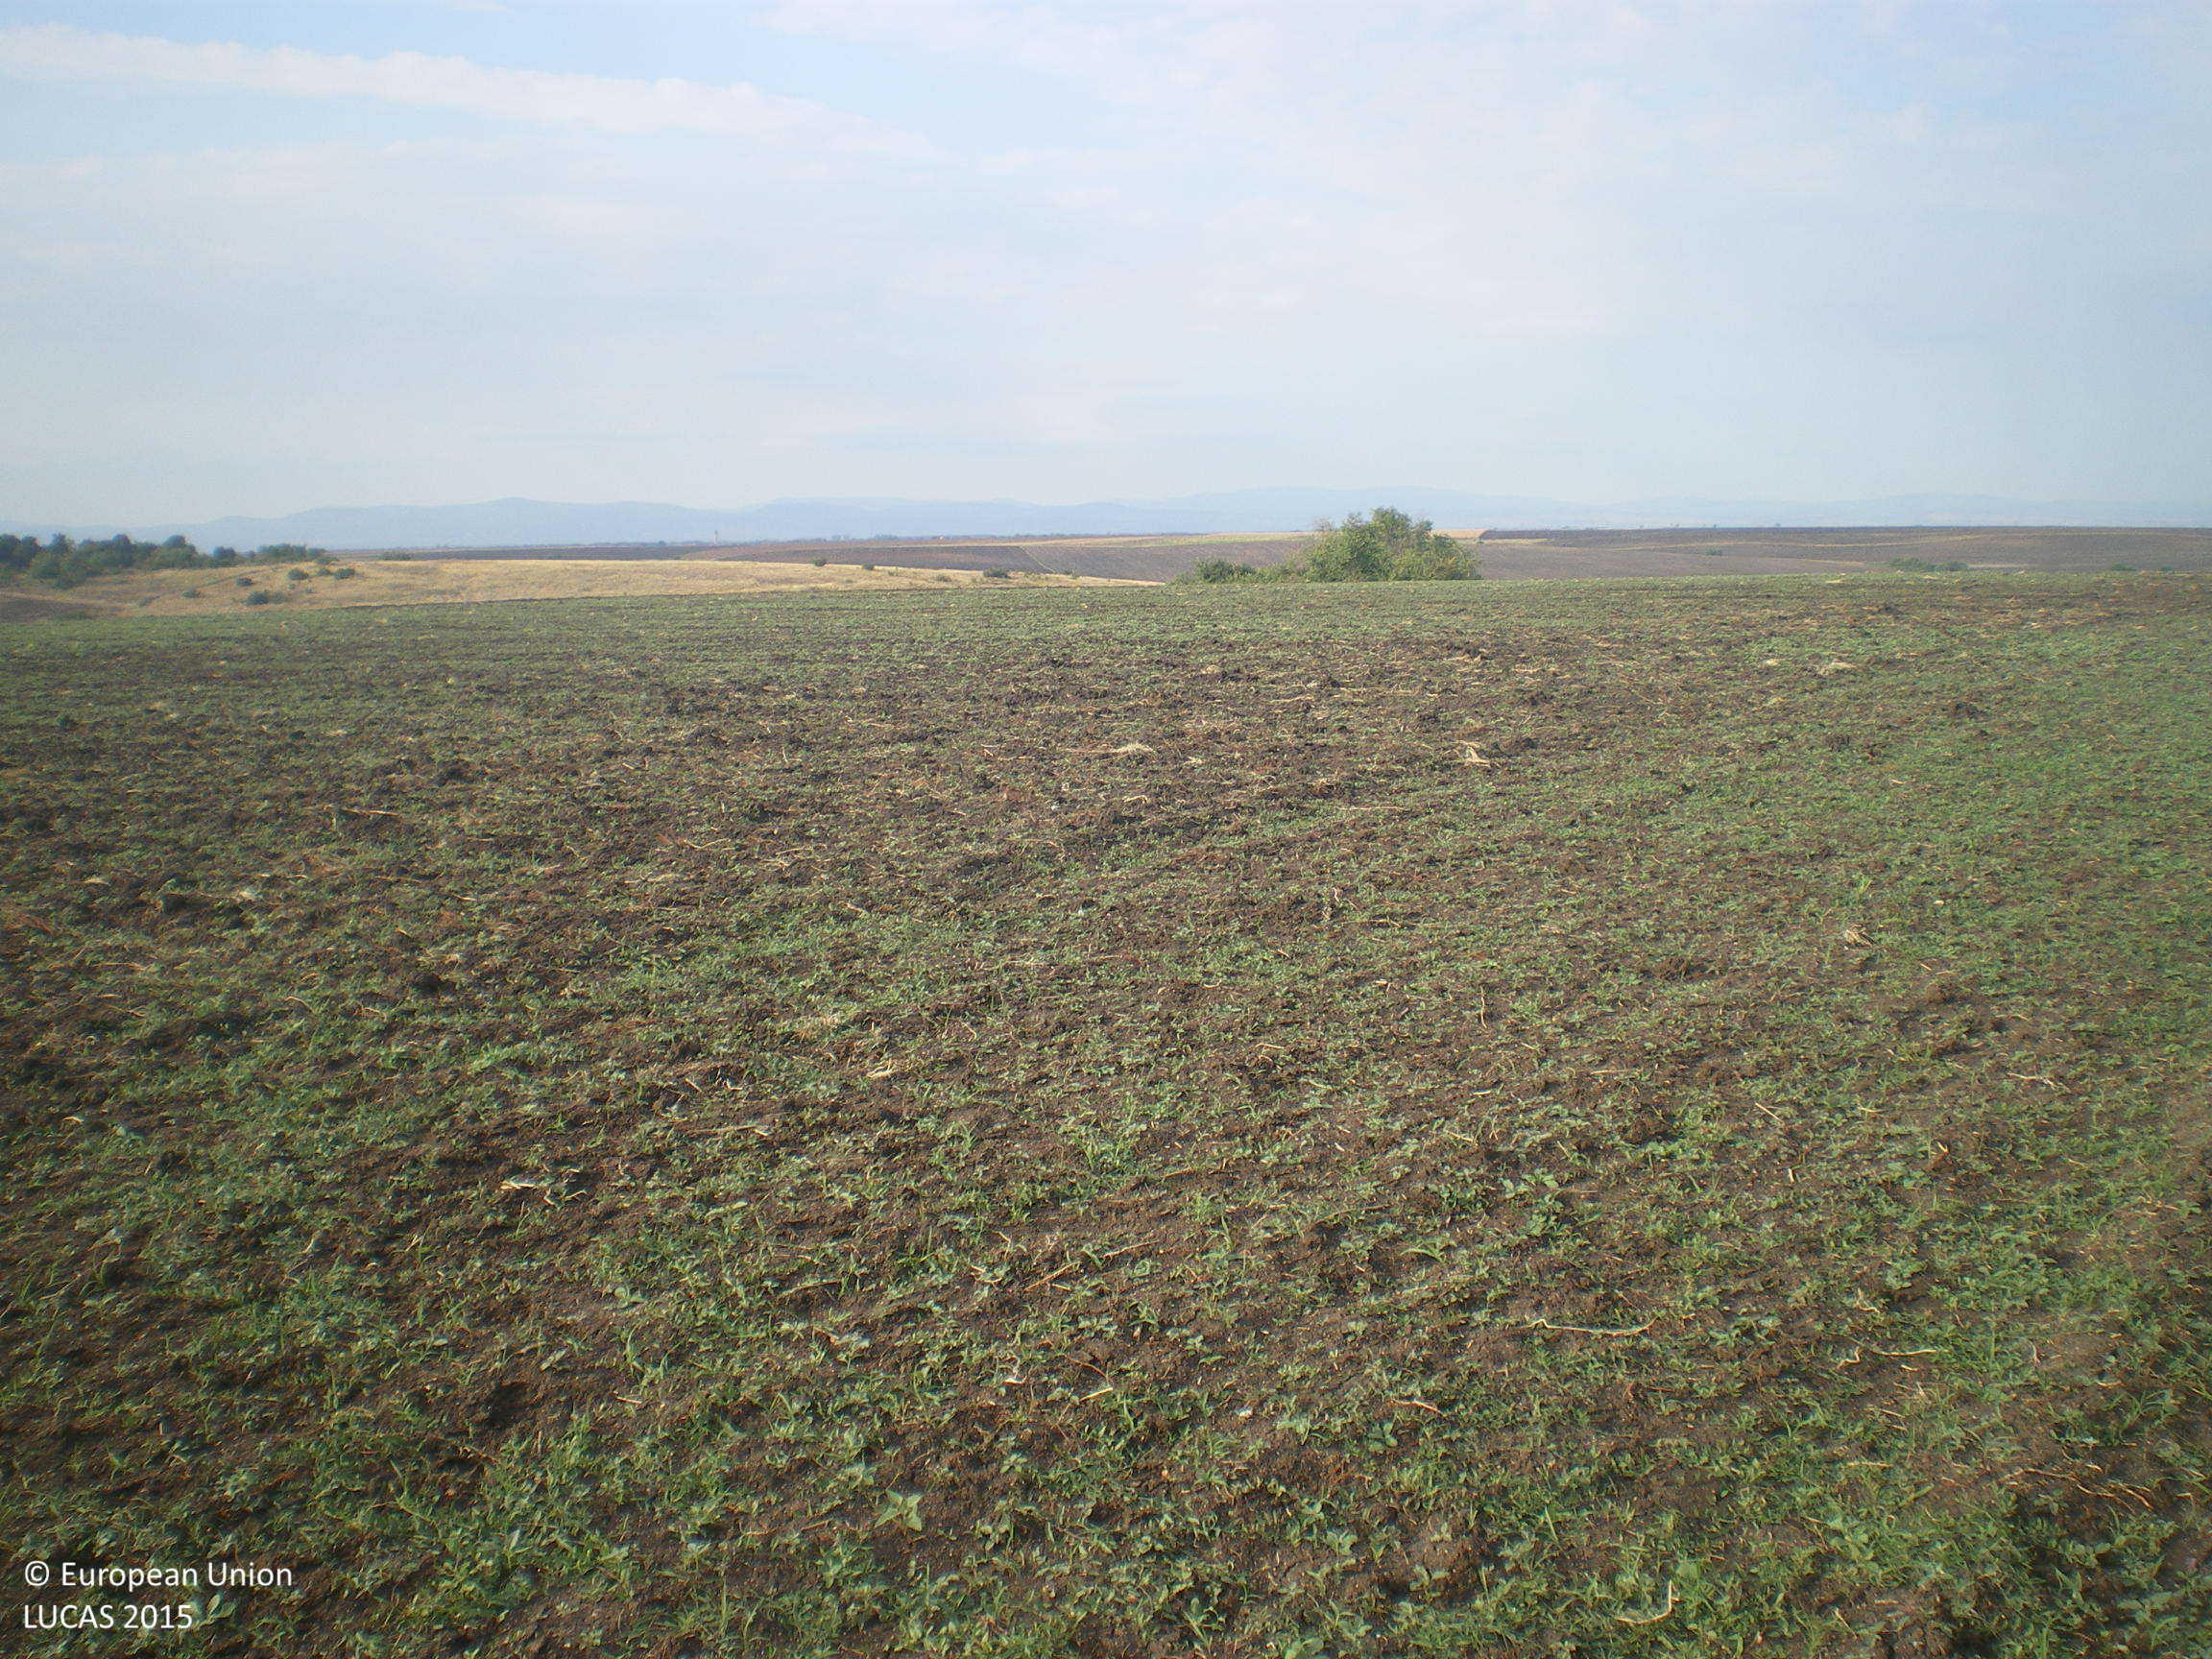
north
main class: Grassland
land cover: Spontaneously vegetated surfaces
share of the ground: 10 - 25 %
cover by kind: herbaceous plants 60 %, consolidated bare surface 40 %
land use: Agriculture (excluding fallow land and kitchen gardens)
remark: Harvested field
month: September
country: BG
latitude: 42.2117
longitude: 25.8078
